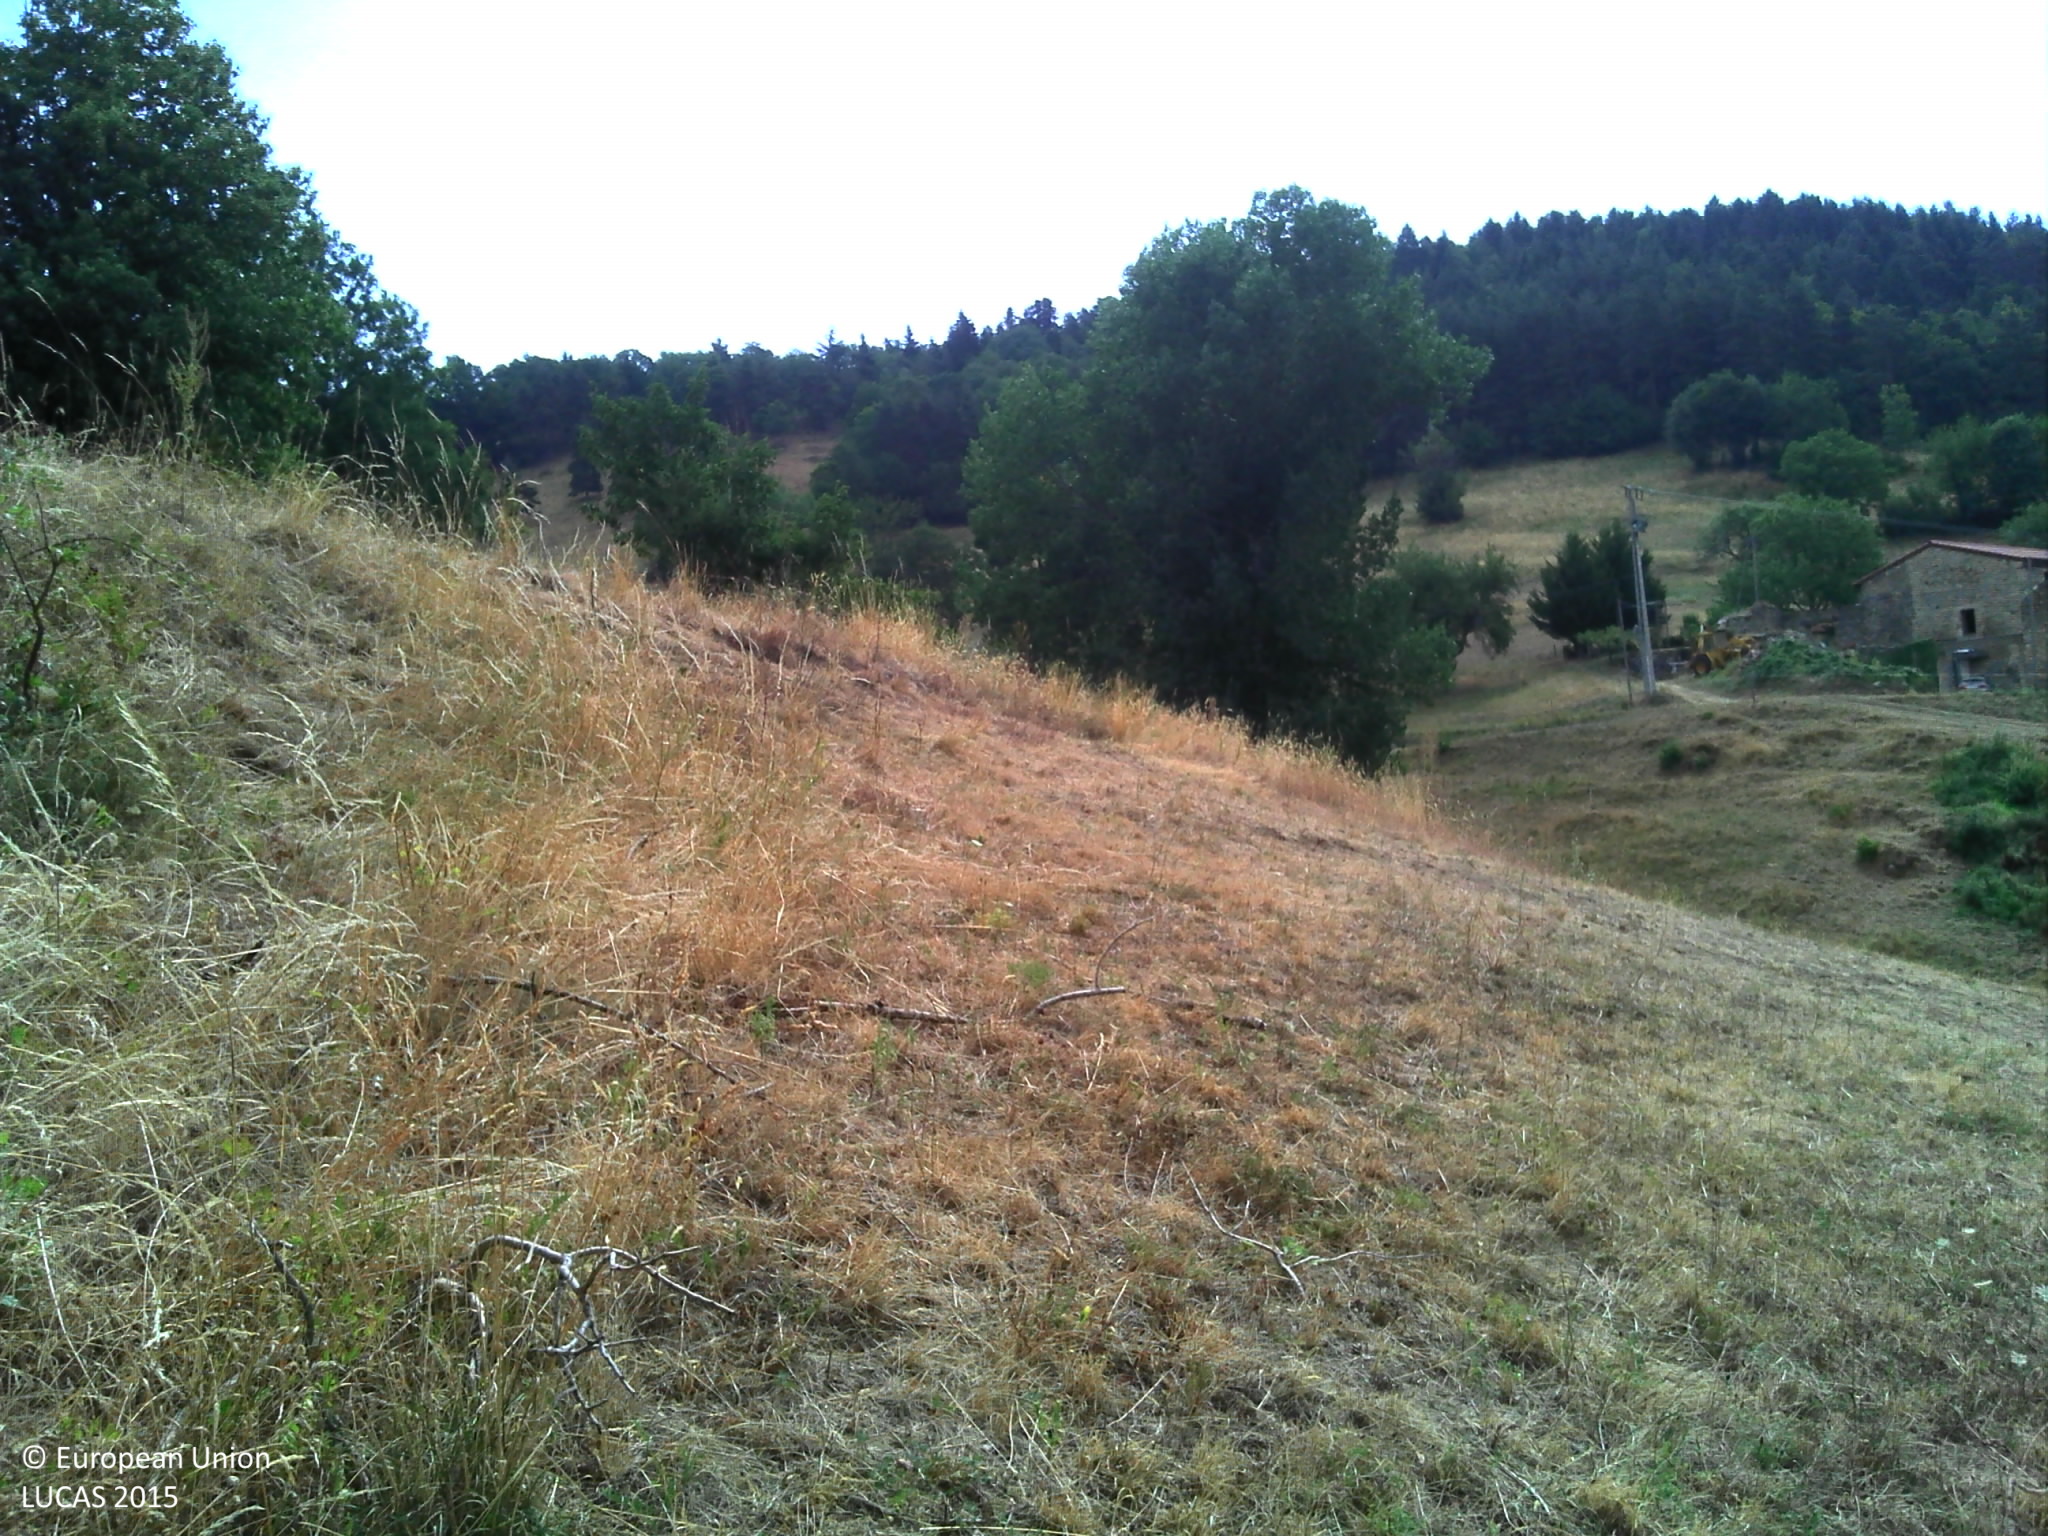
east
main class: Grassland
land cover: Grassland with sparse tree/shrub cover
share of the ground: > 75 %
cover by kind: herbaceous plants 95 %, broadleaved forest trees 5 %
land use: Agriculture (excluding fallow land and kitchen gardens)
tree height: > 5 m
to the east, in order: Grassland with sparse tree/shrub cover; Dry stone walls; Grassland without tree/shrub cover; Single bushes/trees; Dry stone walls; Grassland without tree/shrub cover; Tracks; Grass margins; Broadleaved woodland; Electric lines; Broadleaved woodland; Electric lines; Broadleaved woodland; Artificial constructions in urban areas; Grassland without tree/shrub cover; Dry stone walls; Grassland without tree/shrub cover
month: August
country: FR
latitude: 45.3099
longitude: 4.5581
